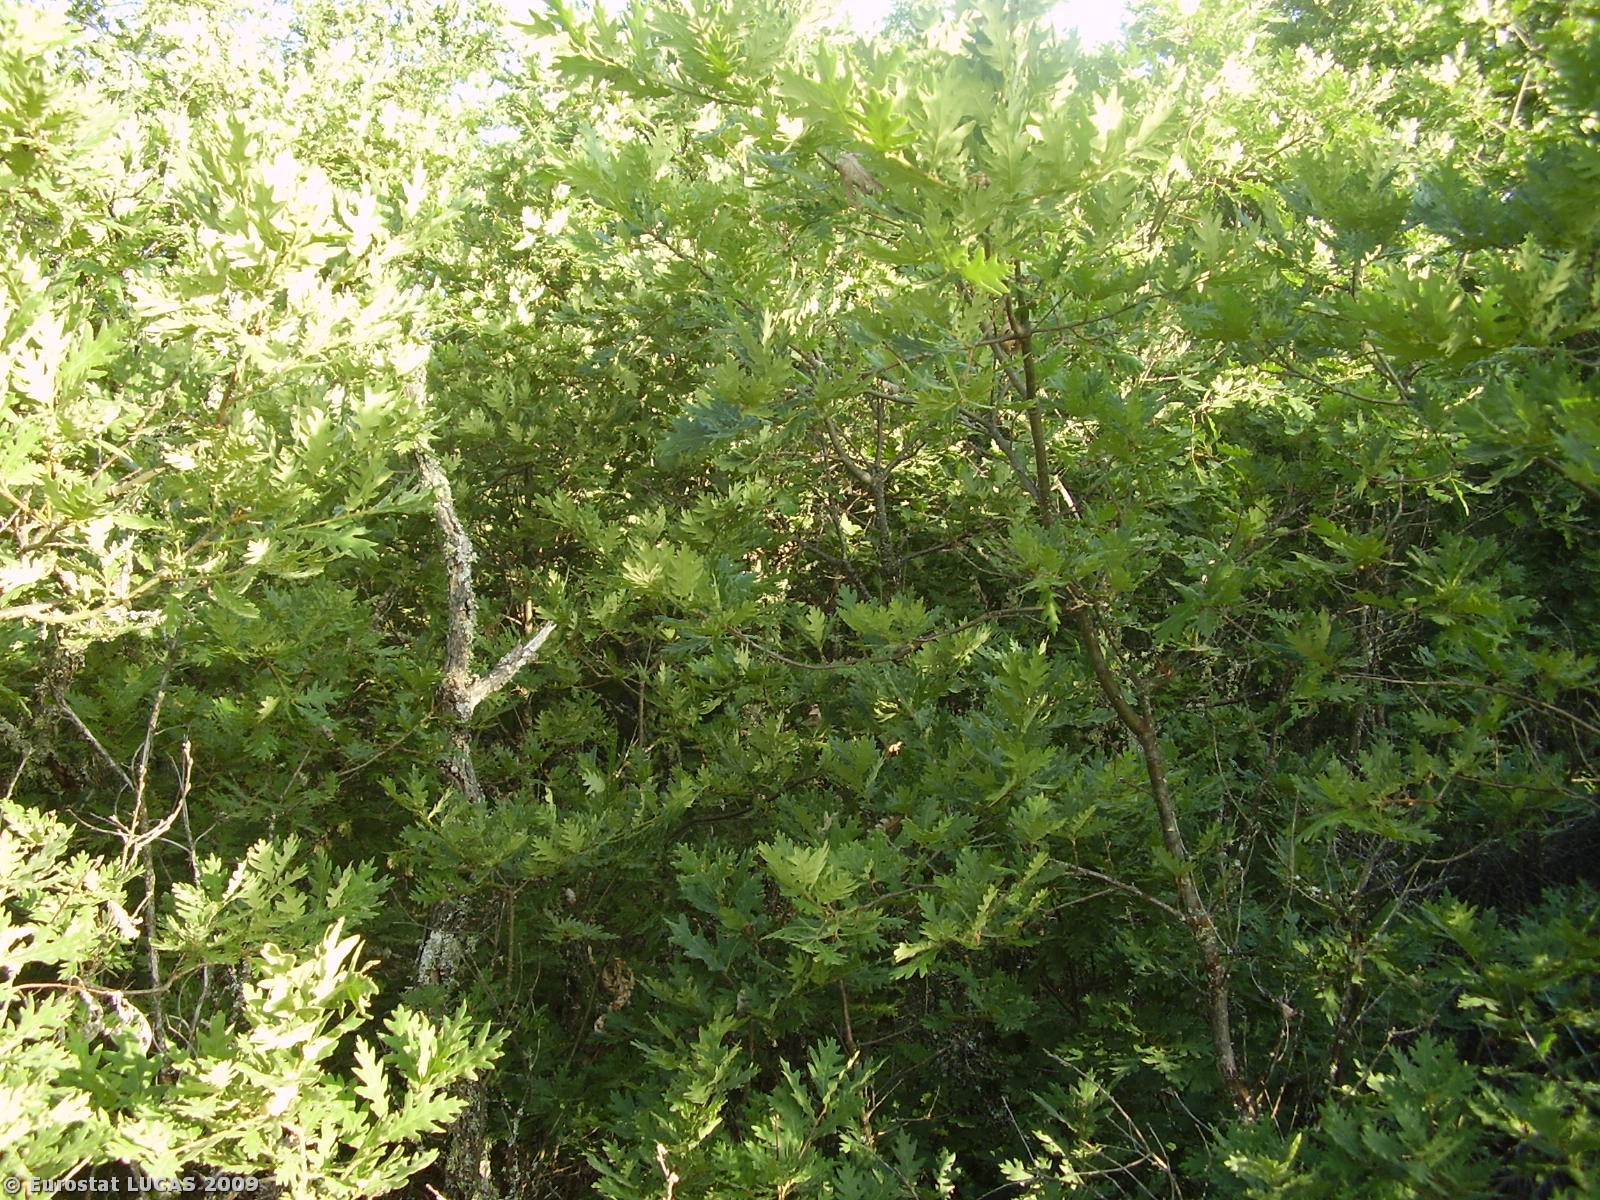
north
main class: Woodland
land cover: Broadleaved woodland
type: thermophilous deciduous forest
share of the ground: > 75 %
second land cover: Spontaneously vegetated surfaces
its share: 10 - 25 %
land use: Nature reserves
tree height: > 5 m
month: June
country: PT
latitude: 41.8176
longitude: -6.8614
